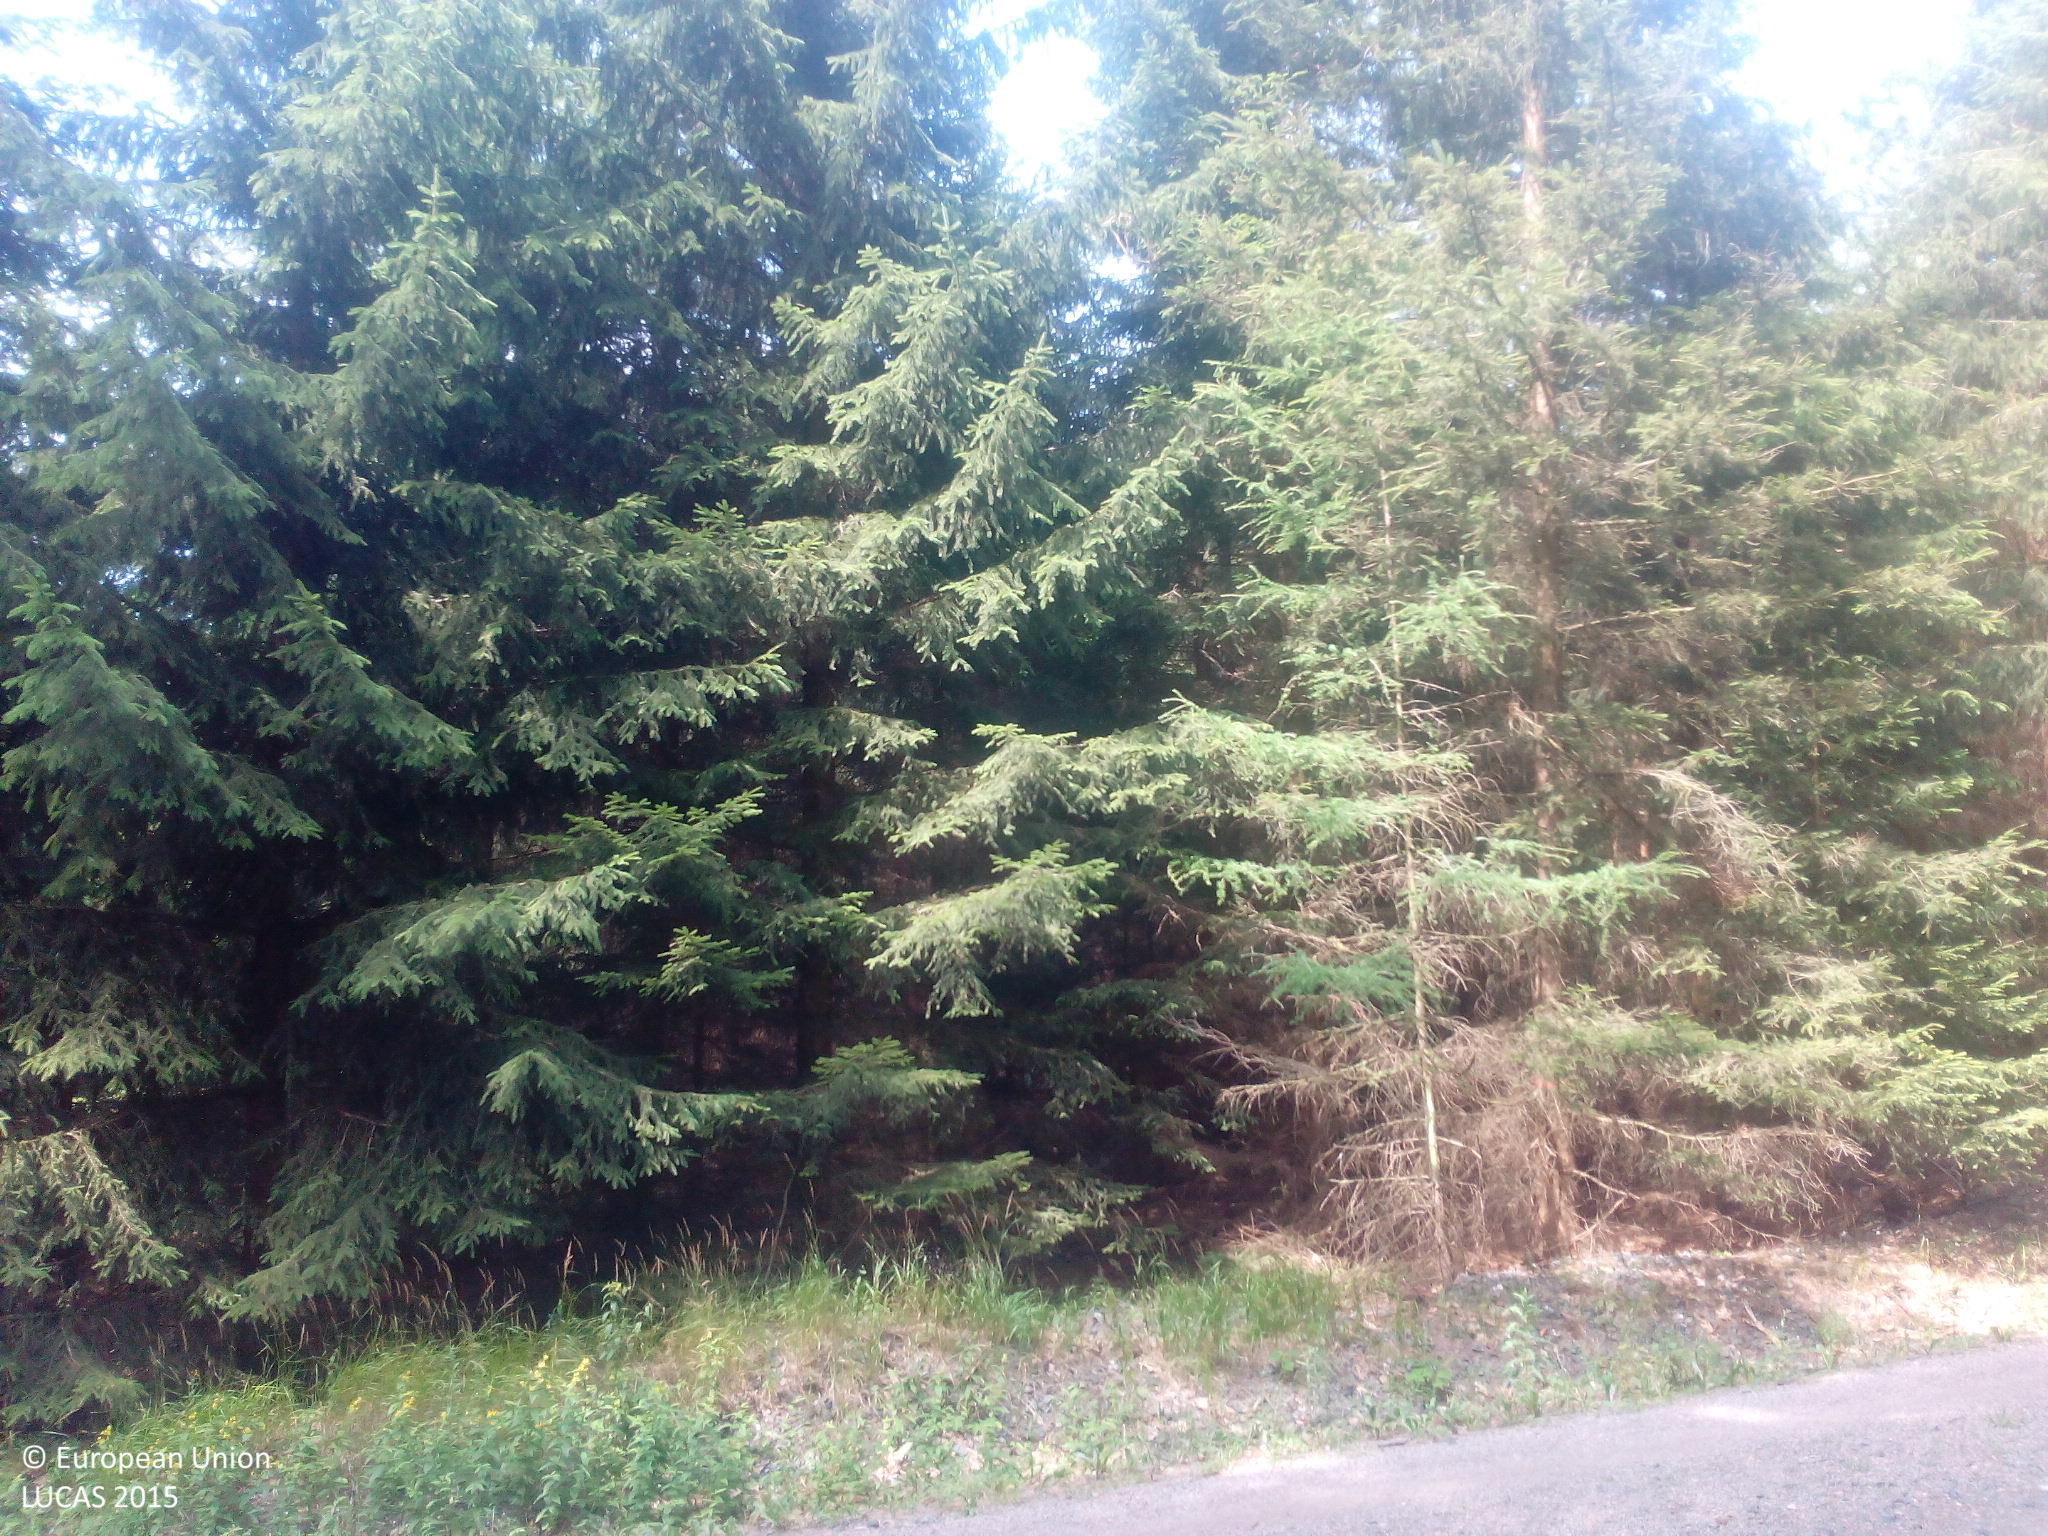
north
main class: Woodland
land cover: Spruce dominated mixed woodland
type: hemiboreal forest and nemoral coniferous forest and mixed broadleaved-coniferous forest
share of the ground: > 75 %
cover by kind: coniferous forest trees 70 %, broadleaved forest trees 30 %
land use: Forestry
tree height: > 5 m
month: July
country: DE
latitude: 50.9588
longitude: 13.4885
